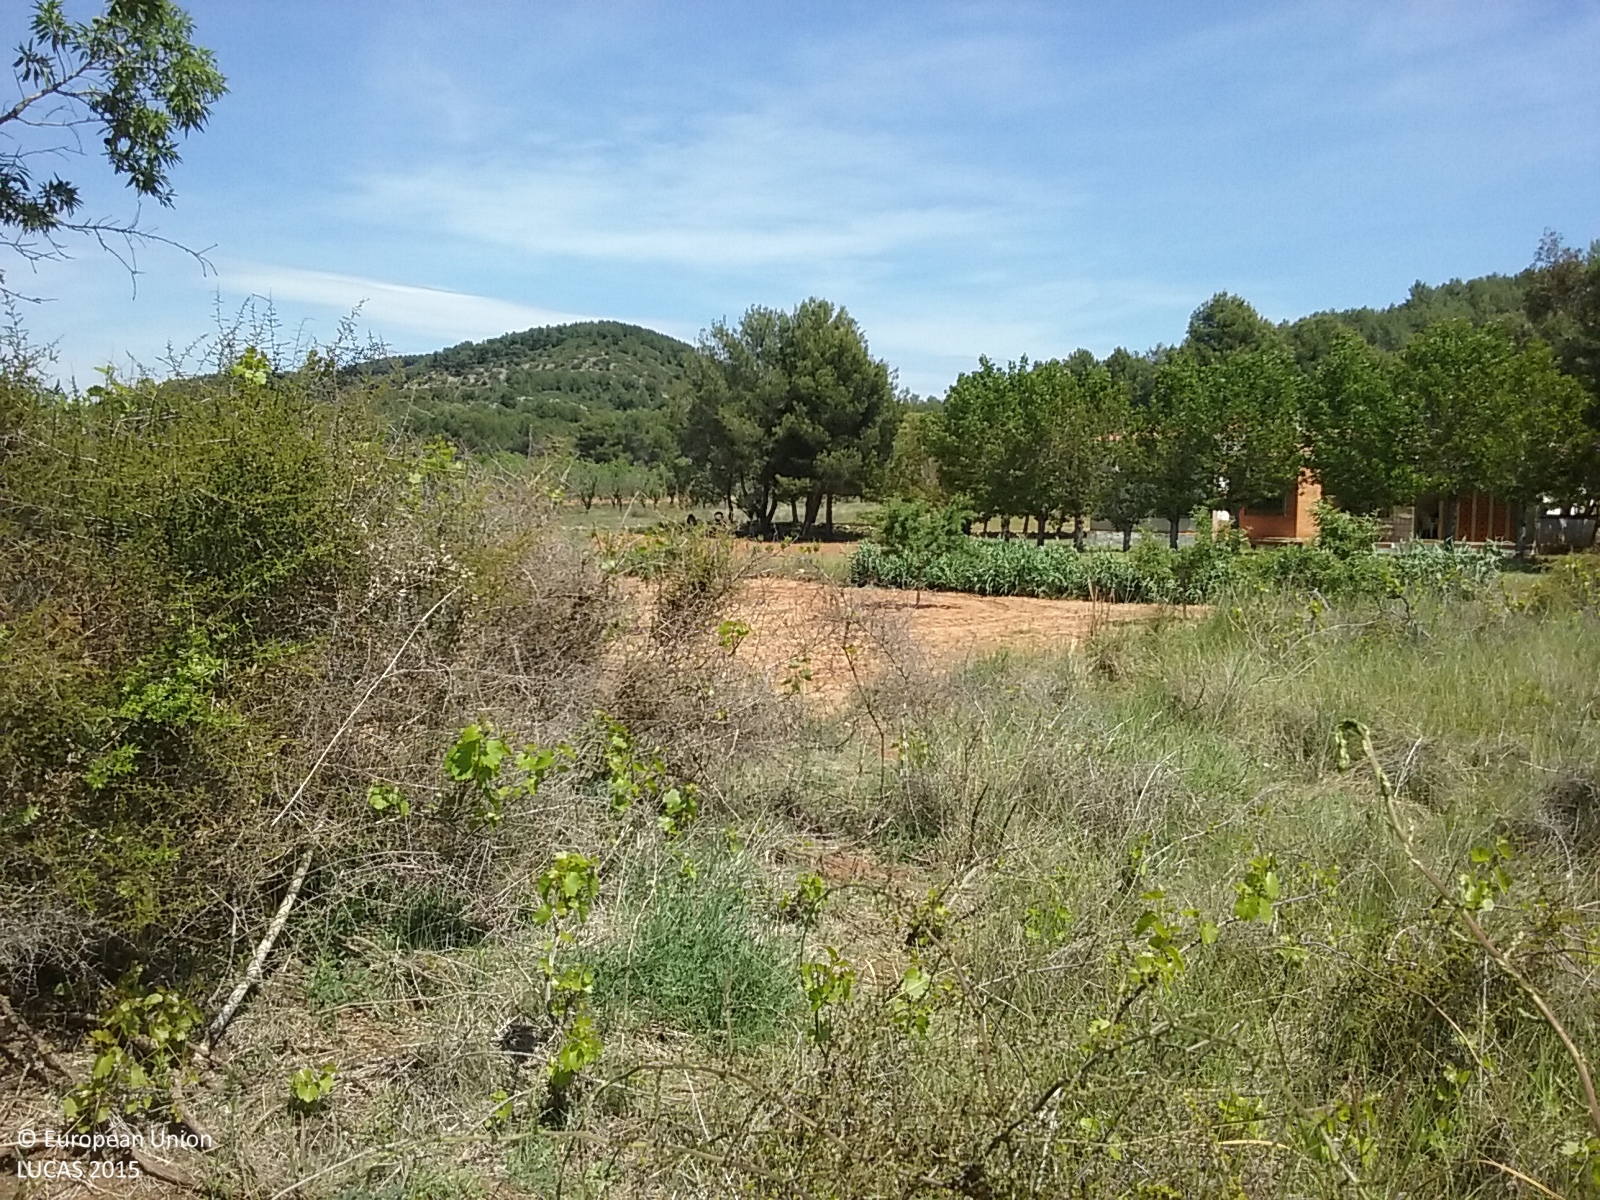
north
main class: Shrubland
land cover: Shrubland with sparse tree cover
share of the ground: > 75 %
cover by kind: herbaceous plants 75 %, shrubs 20 %, broadleaved forest trees 5 %
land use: Abandoned areas
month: May
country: ES
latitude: 40.1208
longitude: 0.0123
